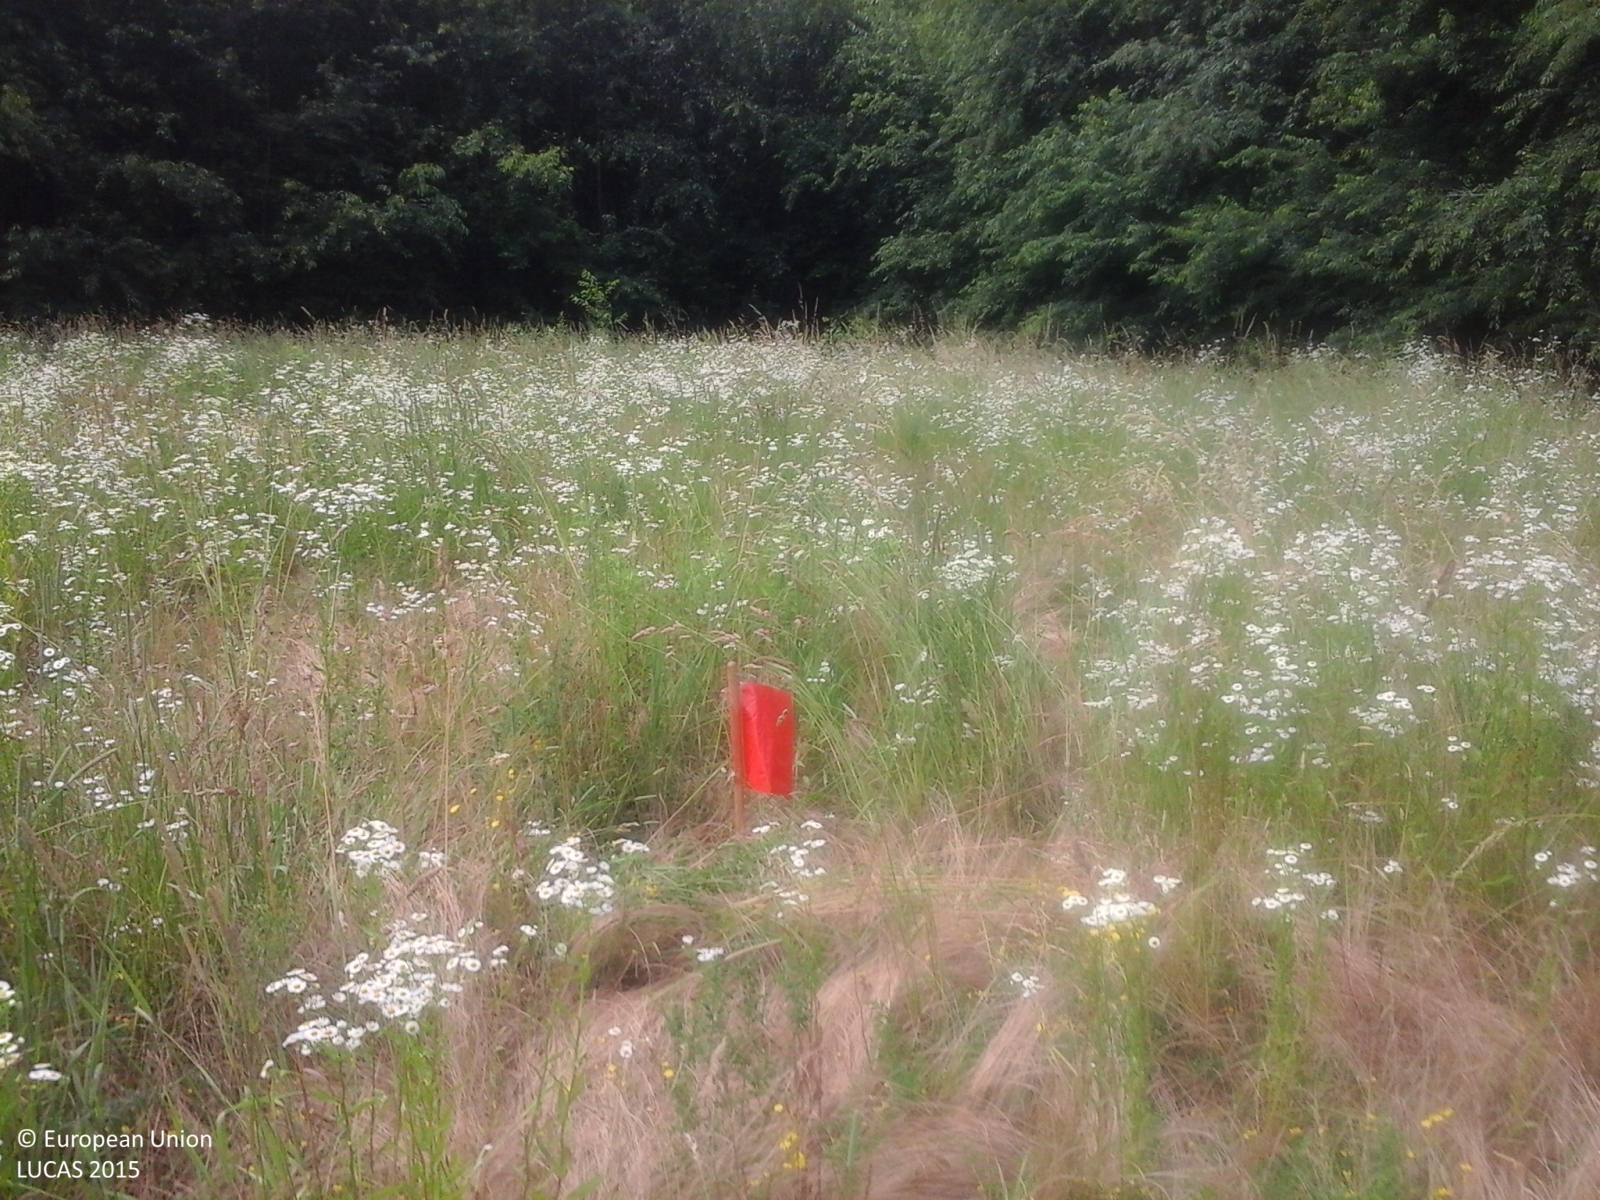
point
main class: Grassland
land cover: Spontaneously vegetated surfaces
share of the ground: > 75 %
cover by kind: herbaceous plants 100 %
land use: Fallow land
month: June
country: IT
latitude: 45.5698
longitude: 8.8103
